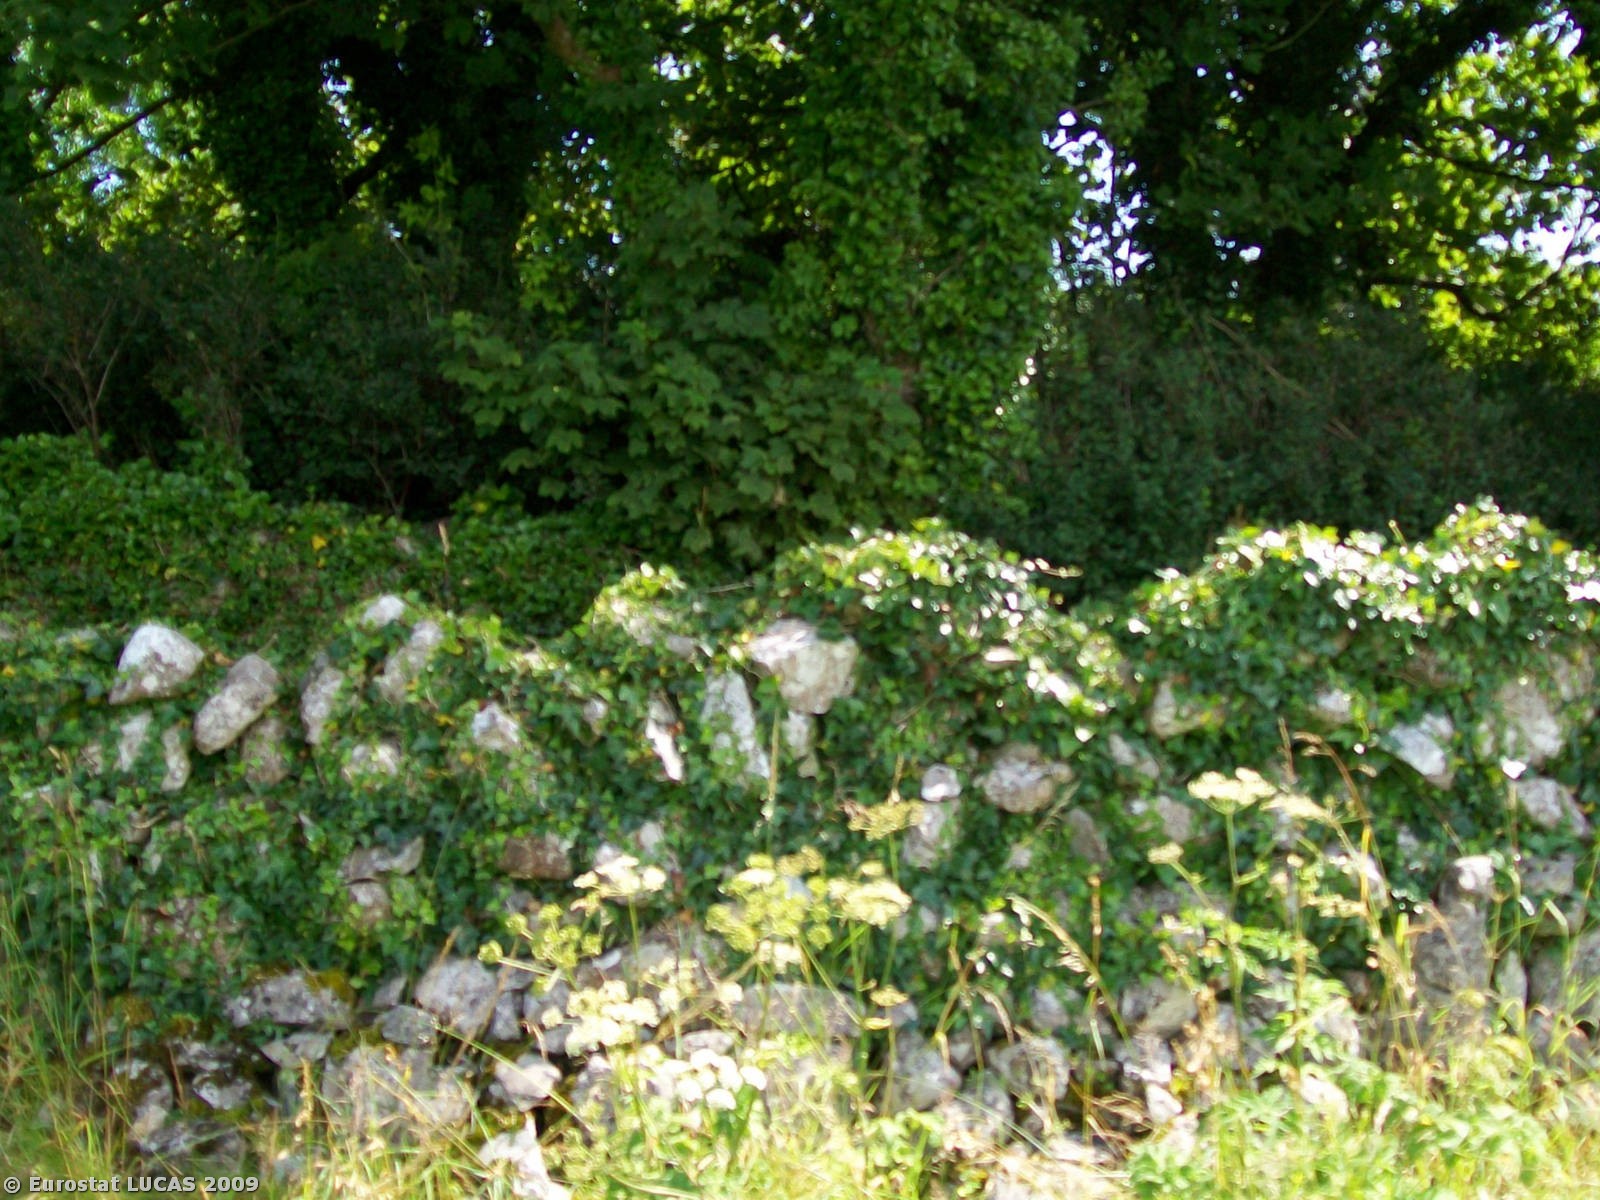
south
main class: Grassland
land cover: Grassland without tree/shrub cover
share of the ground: > 75 %
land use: Agriculture (excluding fallow land and kitchen gardens)
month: July
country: IE
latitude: 53.1811
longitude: -8.7112
